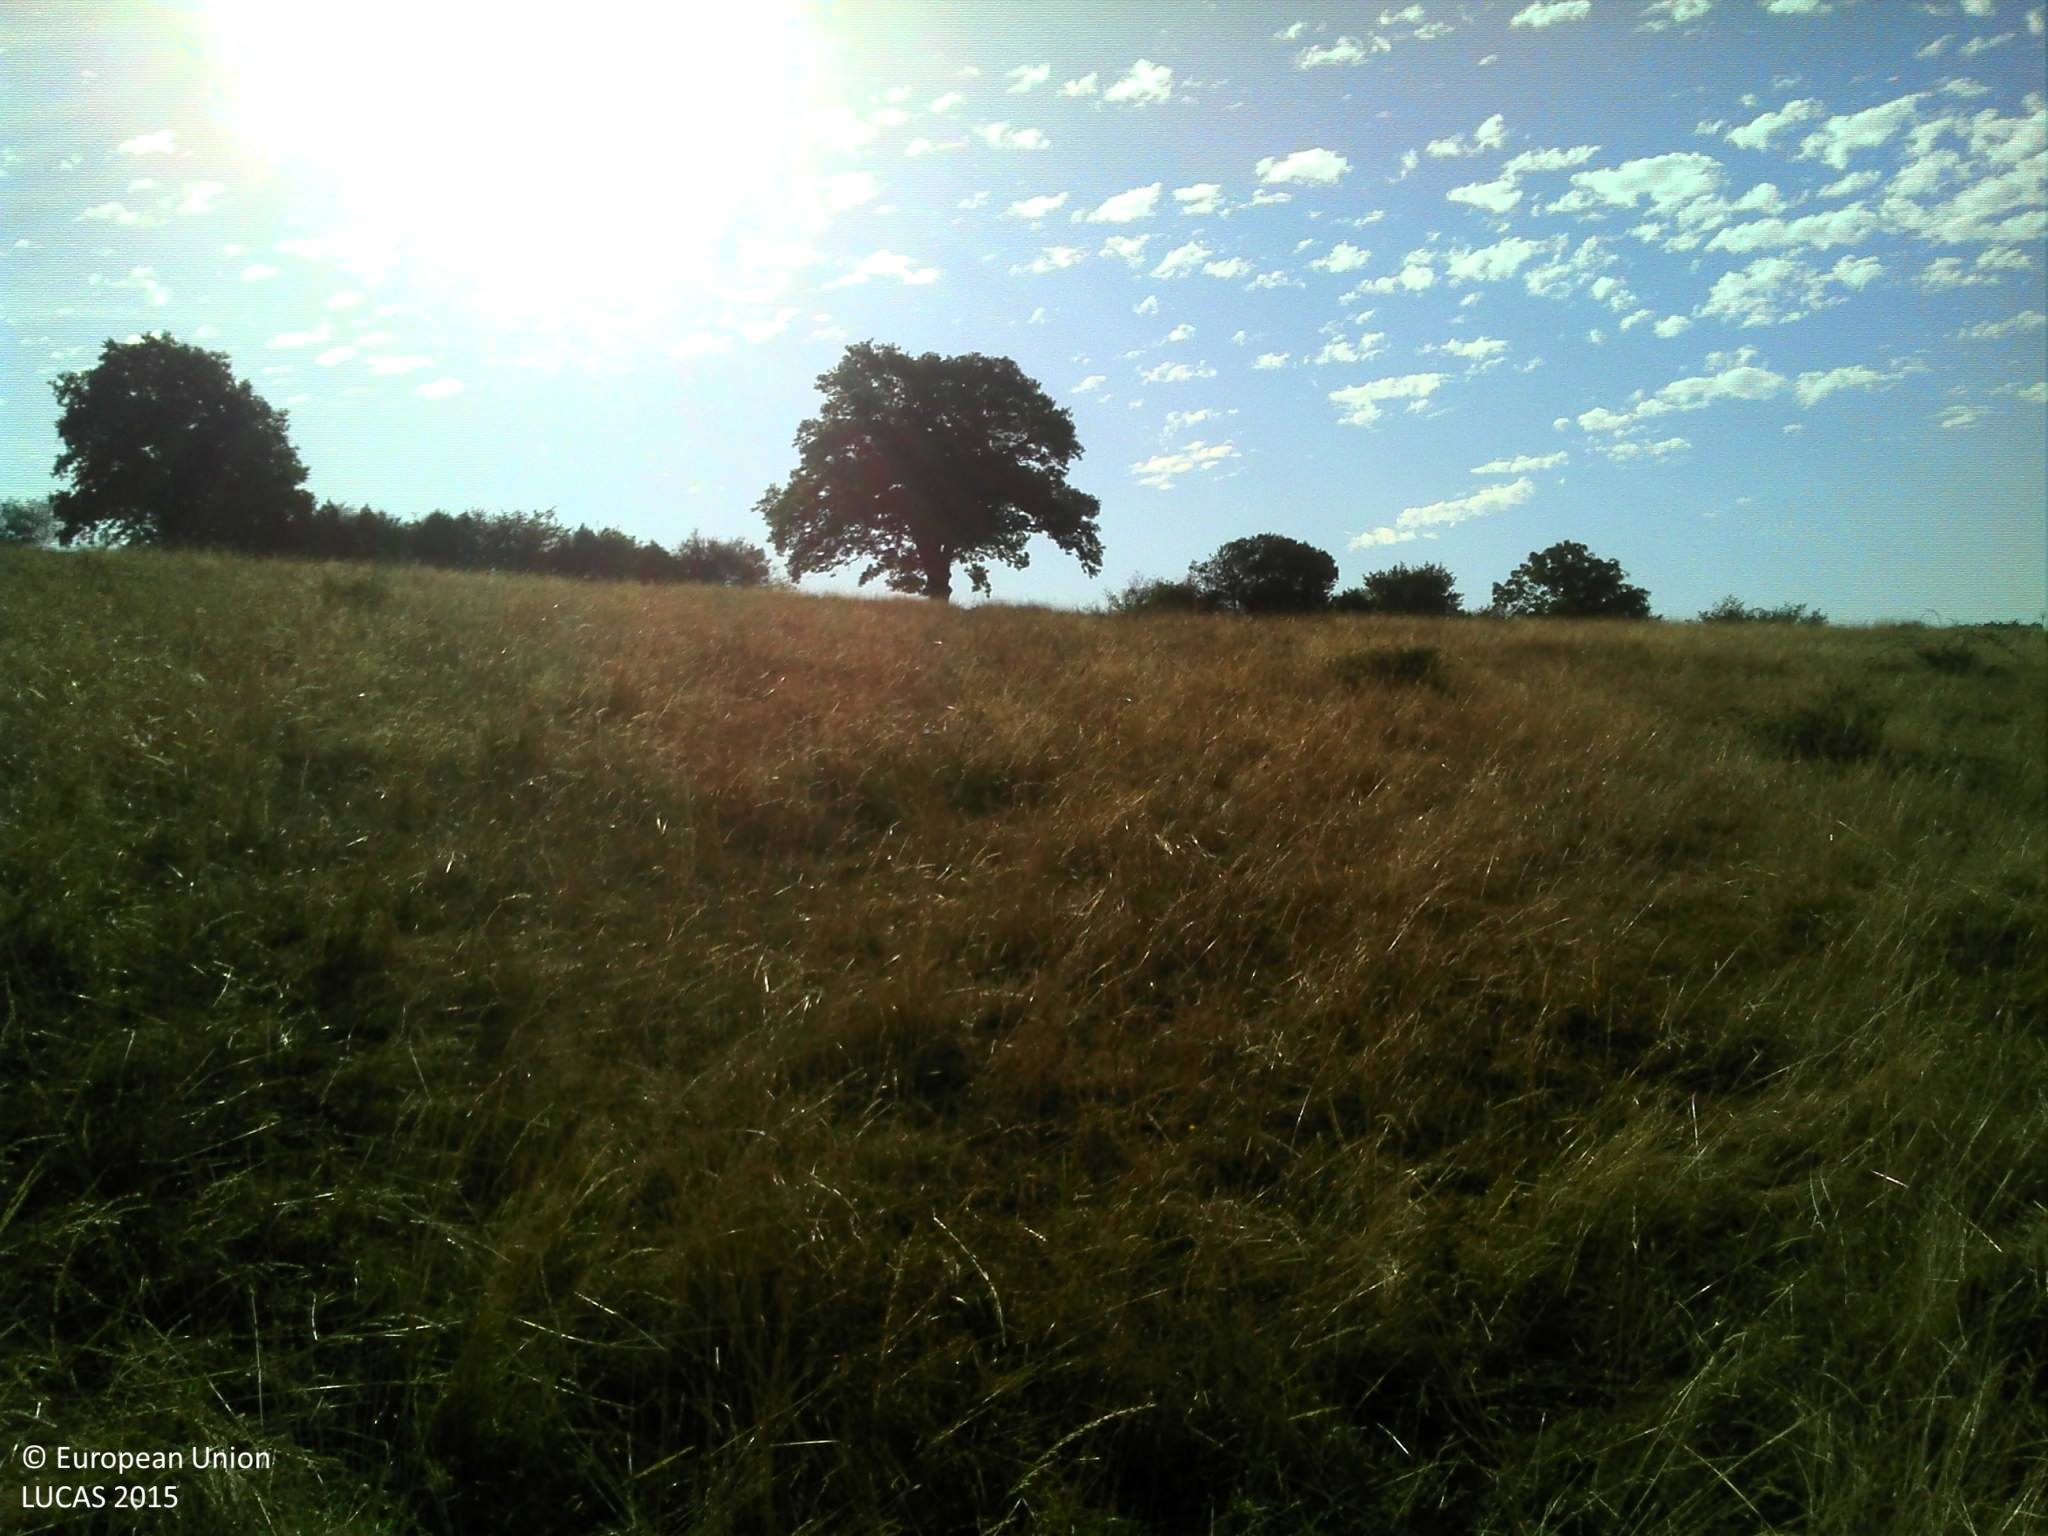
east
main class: Grassland
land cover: Grassland without tree/shrub cover
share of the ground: > 75 %
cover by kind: herbaceous plants 100 %
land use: Agriculture (excluding fallow land and kitchen gardens)
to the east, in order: Grassland without tree/shrub cover; Abandoned hedges; Grassland without tree/shrub cover; Abandoned hedges; Fences; Grassland without tree/shrub cover
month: August
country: FR
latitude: 46.8516
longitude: 4.3476
